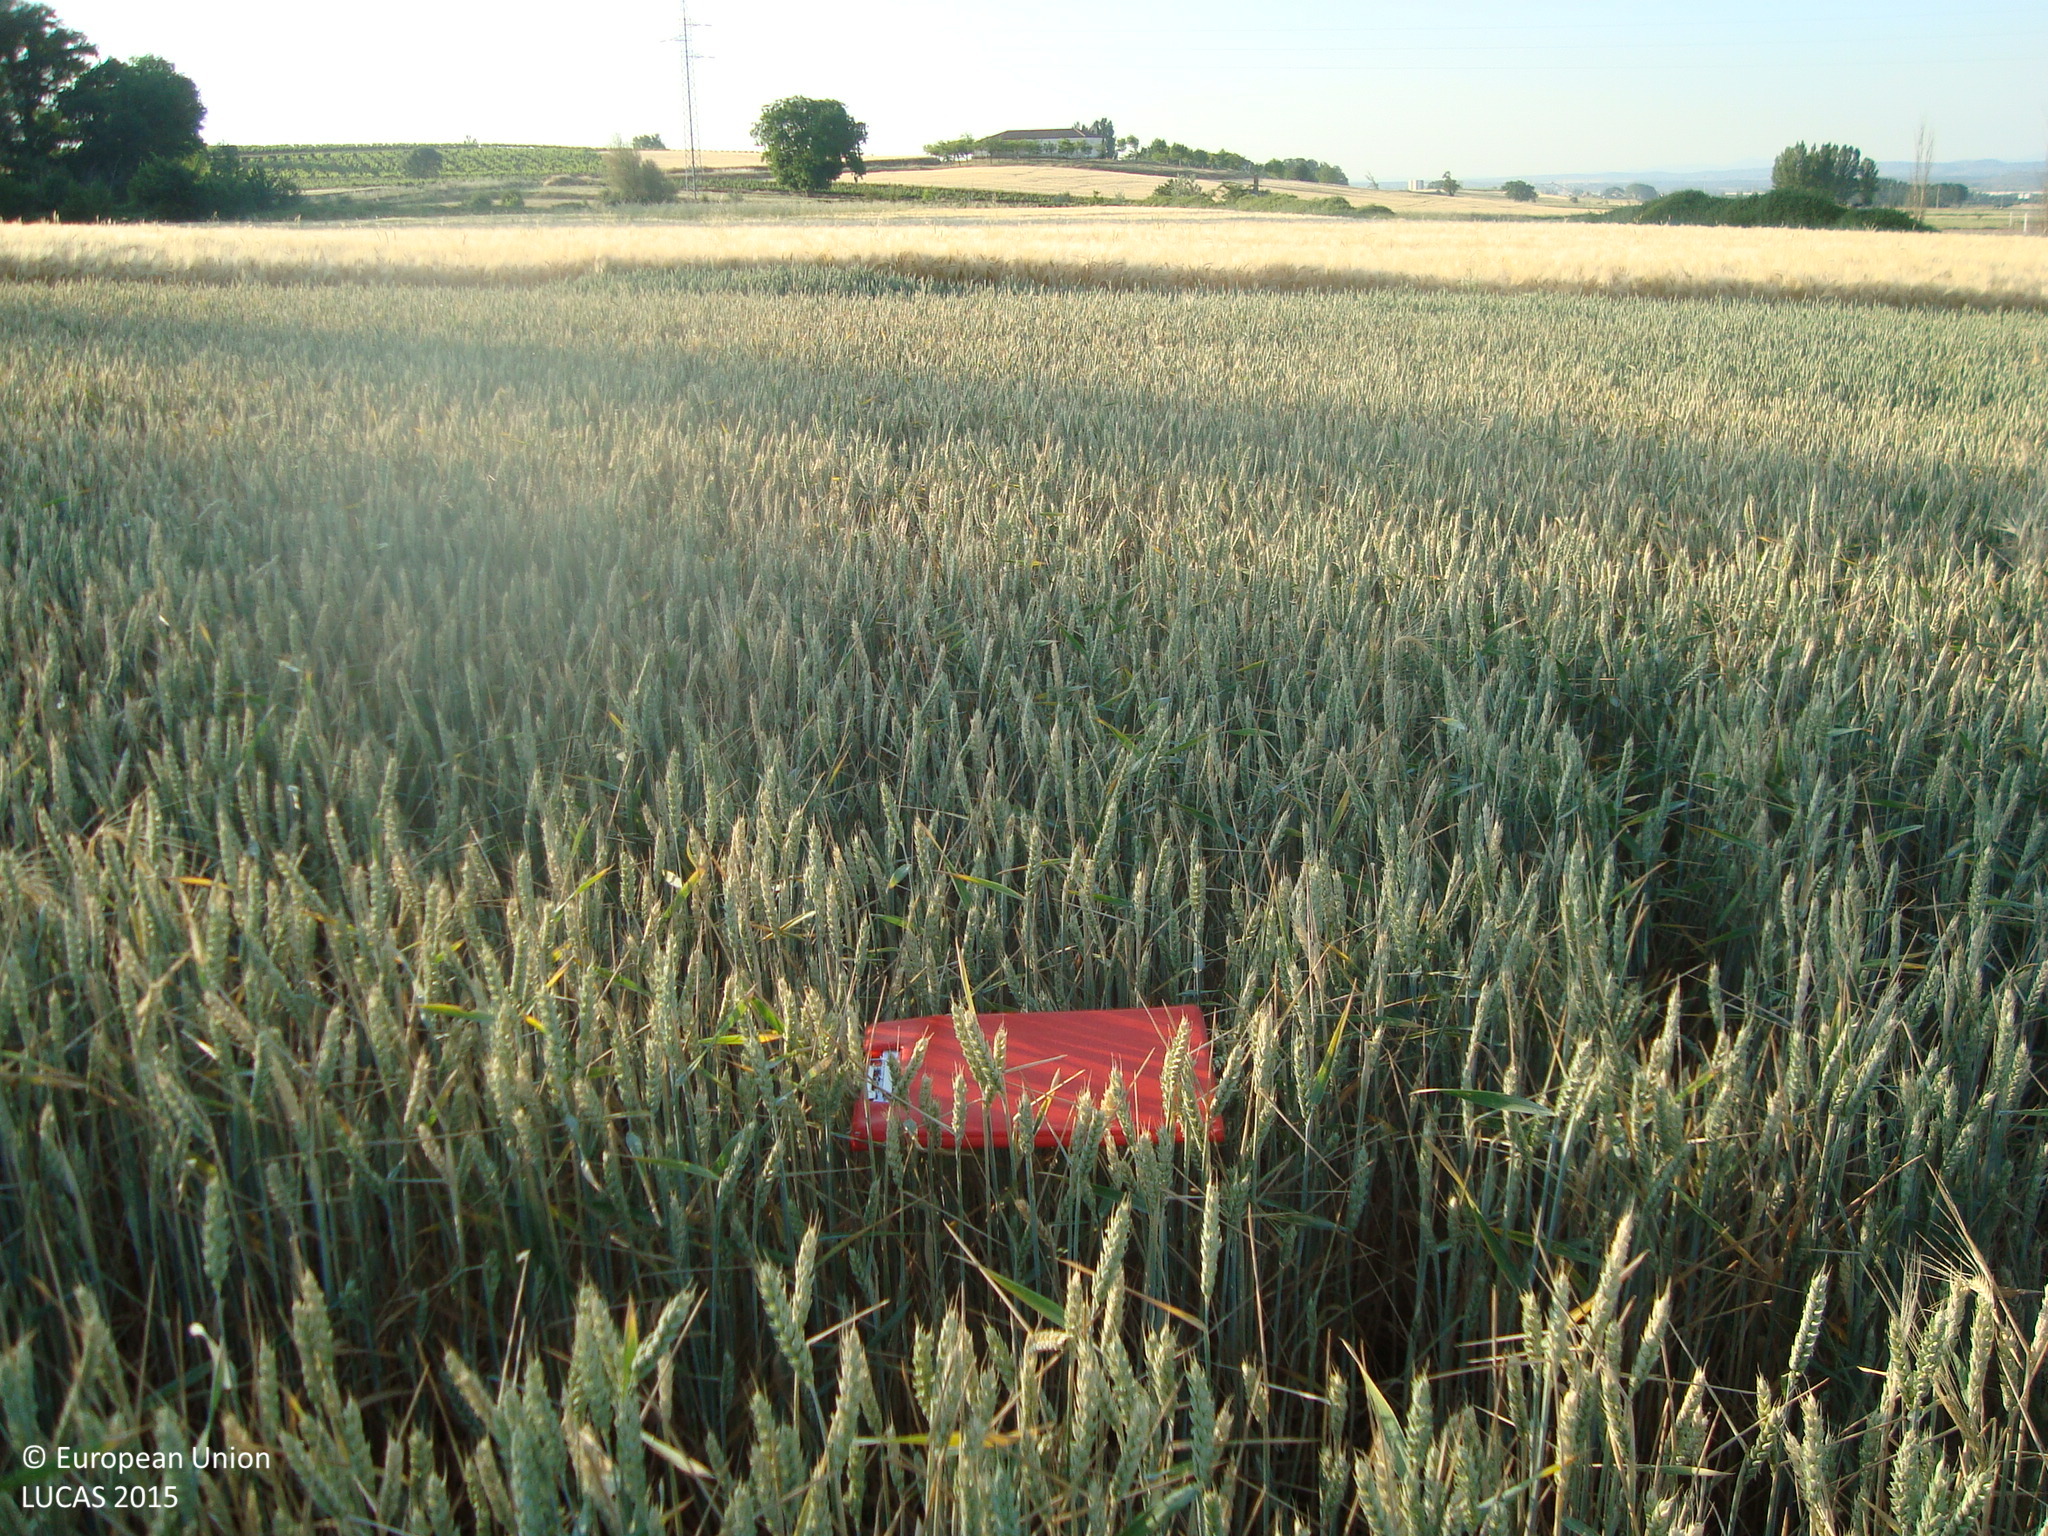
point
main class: Cropland
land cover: Common wheat
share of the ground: > 75 %
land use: Agriculture (excluding fallow land and kitchen gardens)
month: June
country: ES
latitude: 41.6944
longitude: -3.7394
